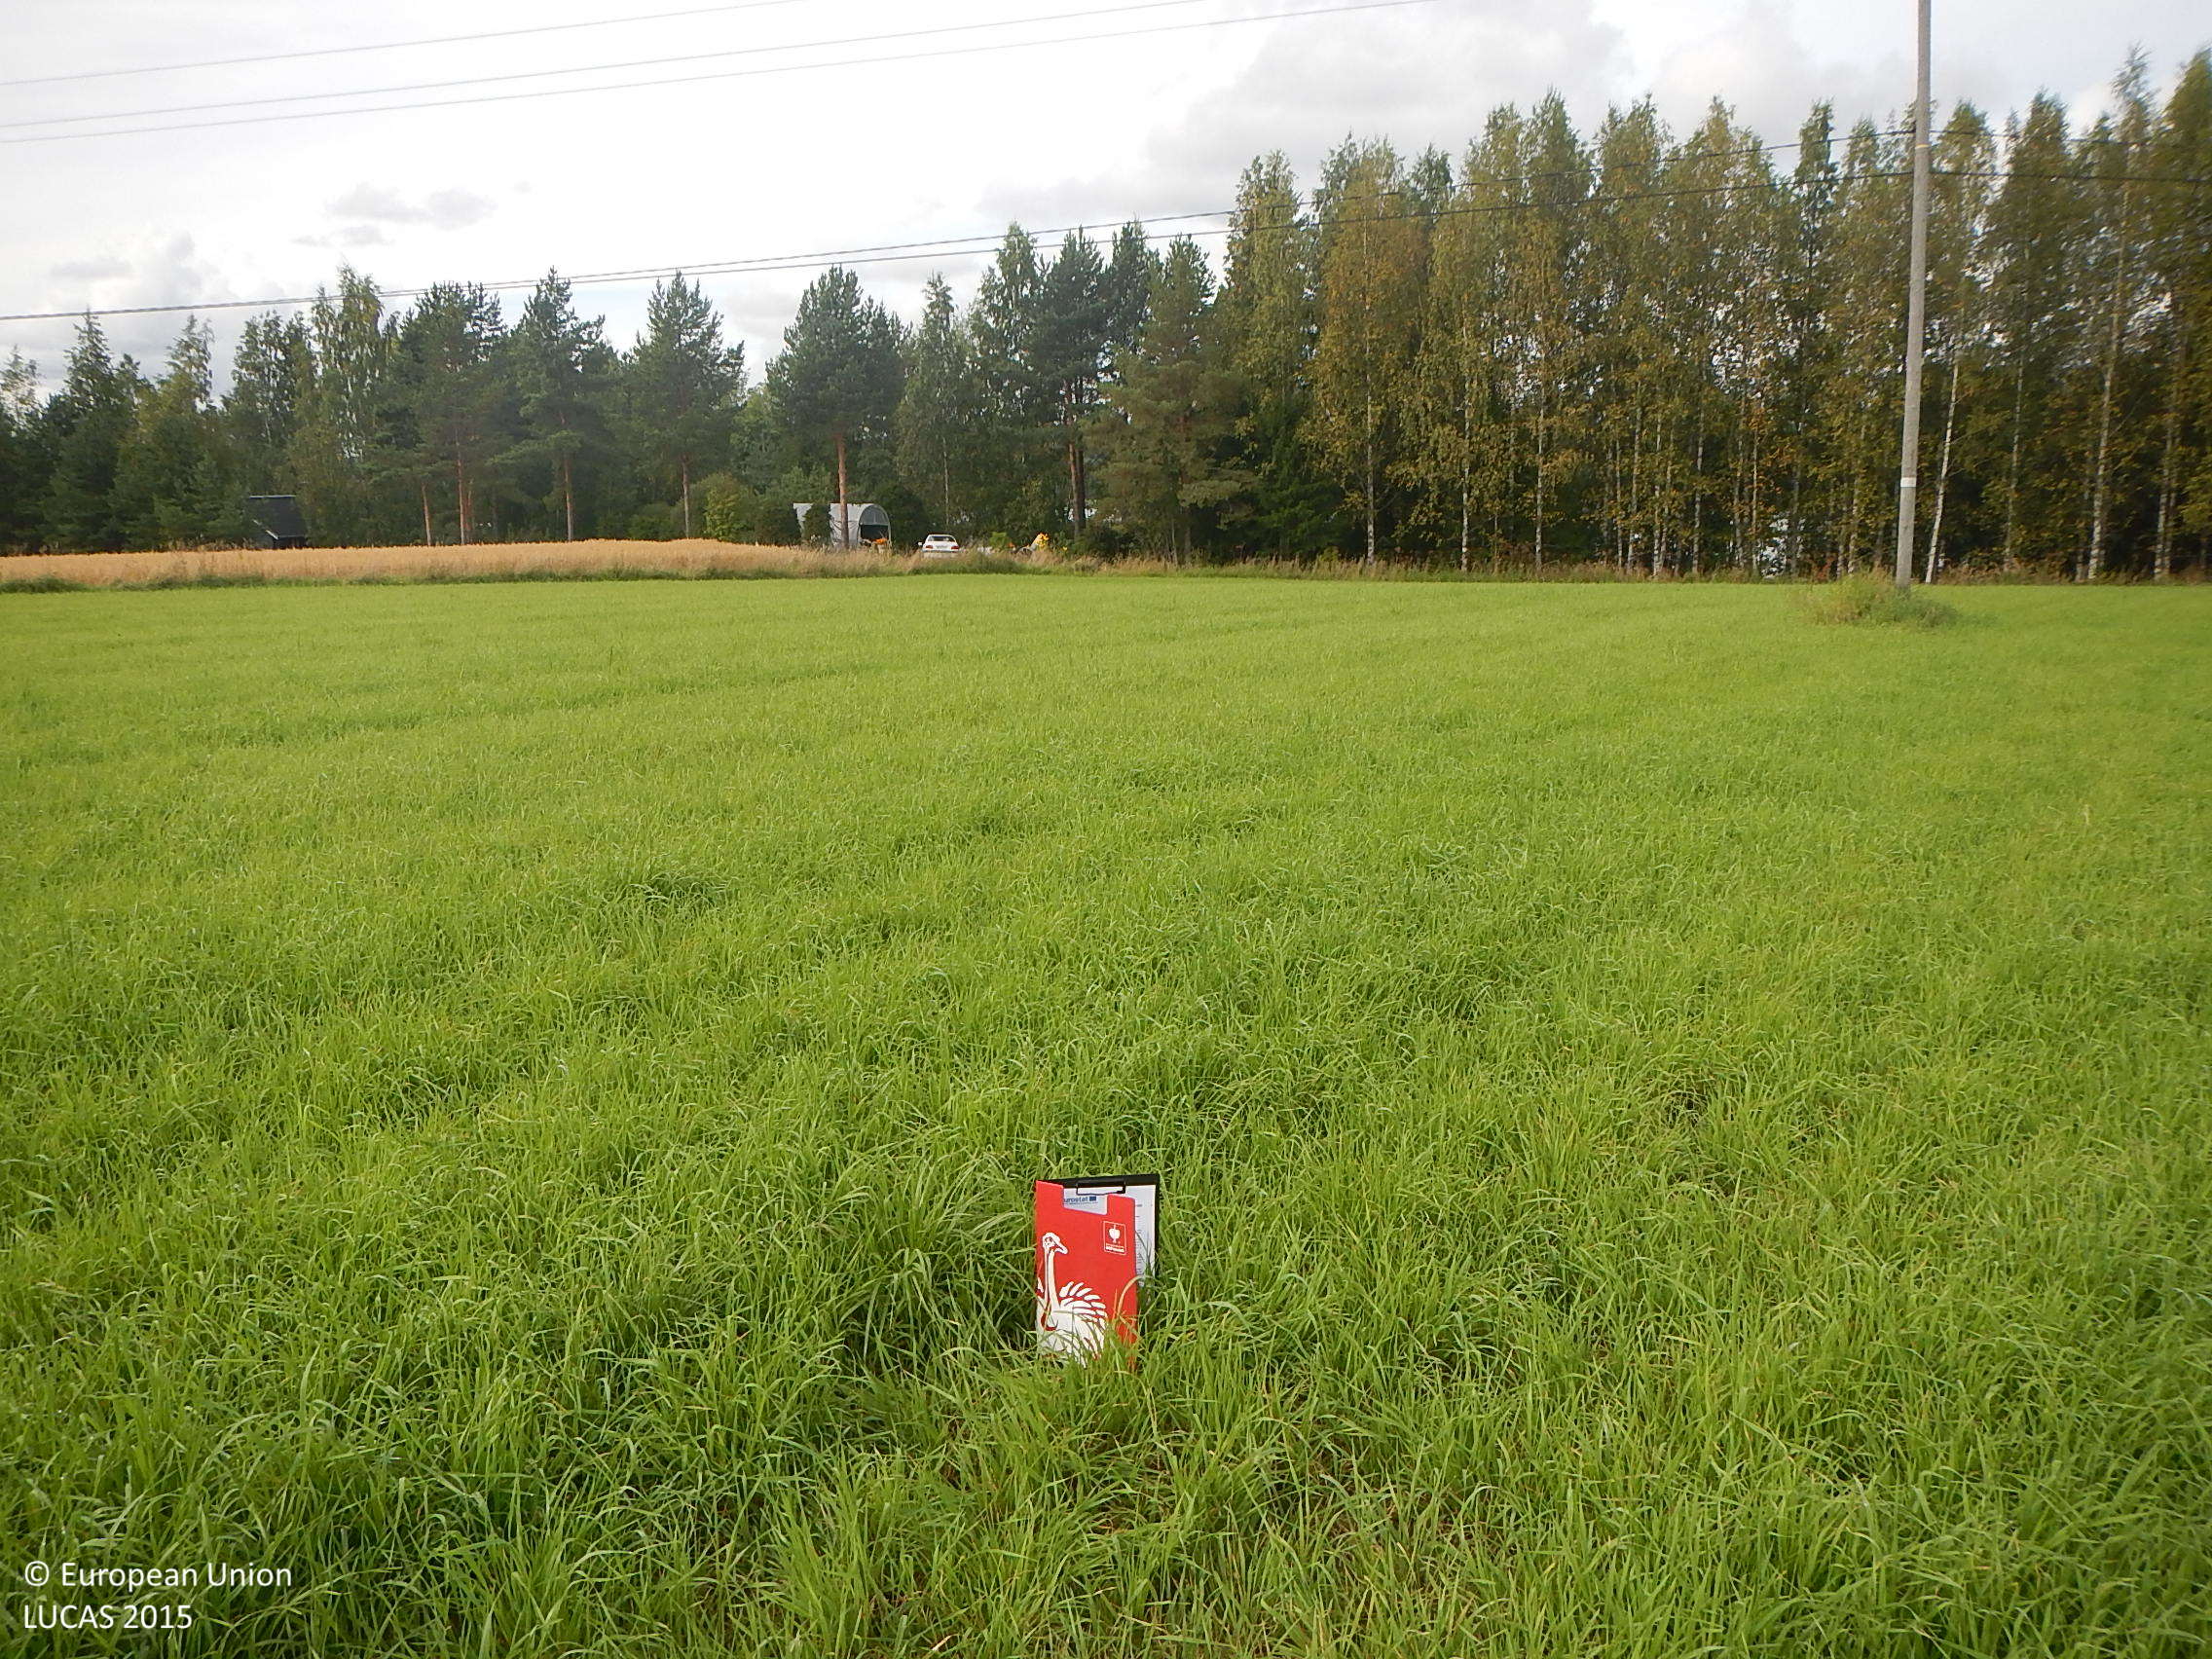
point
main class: Cropland
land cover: Temporary grasslands
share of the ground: > 75 %
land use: Agriculture (excluding fallow land and kitchen gardens)
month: September
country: FI
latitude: 61.4357
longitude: 23.0649
